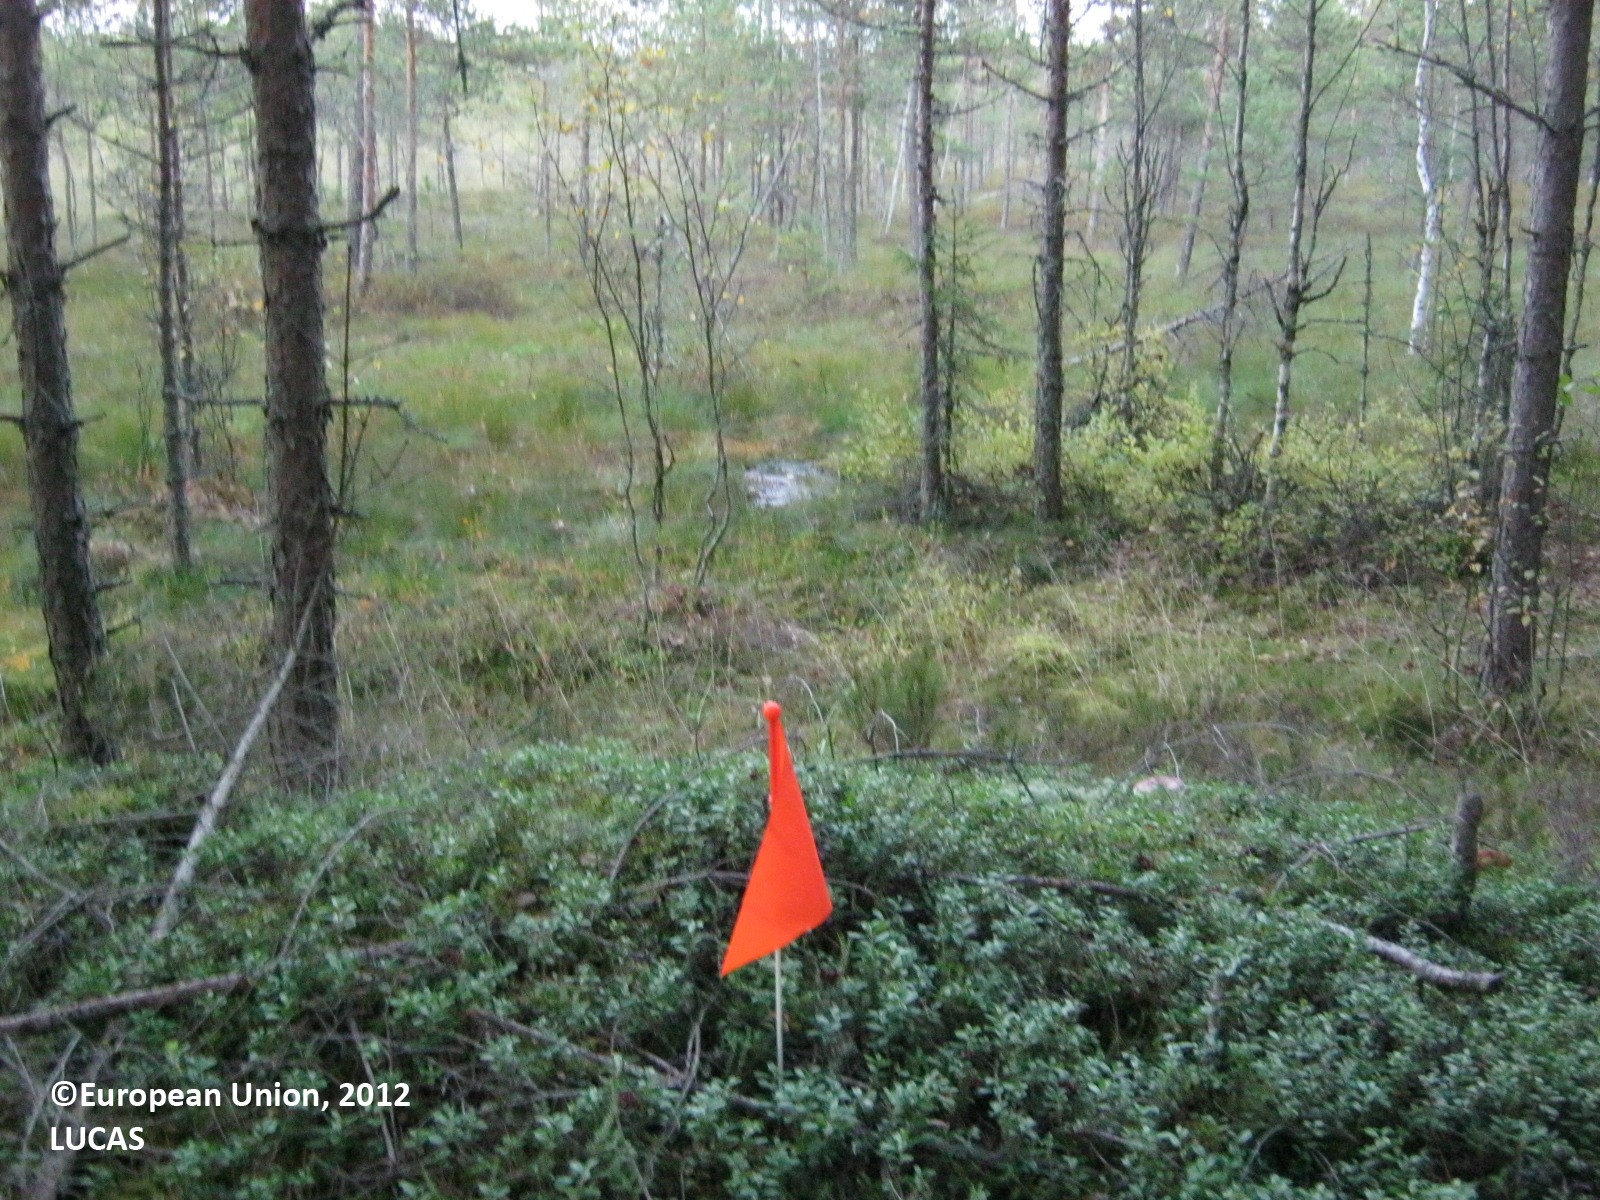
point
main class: Woodland
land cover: Pine dominated coniferous woodland
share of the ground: 50 - 75 %
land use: Forestry
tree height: < 5 m
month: September
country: FI
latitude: 60.8835
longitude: 27.9779
